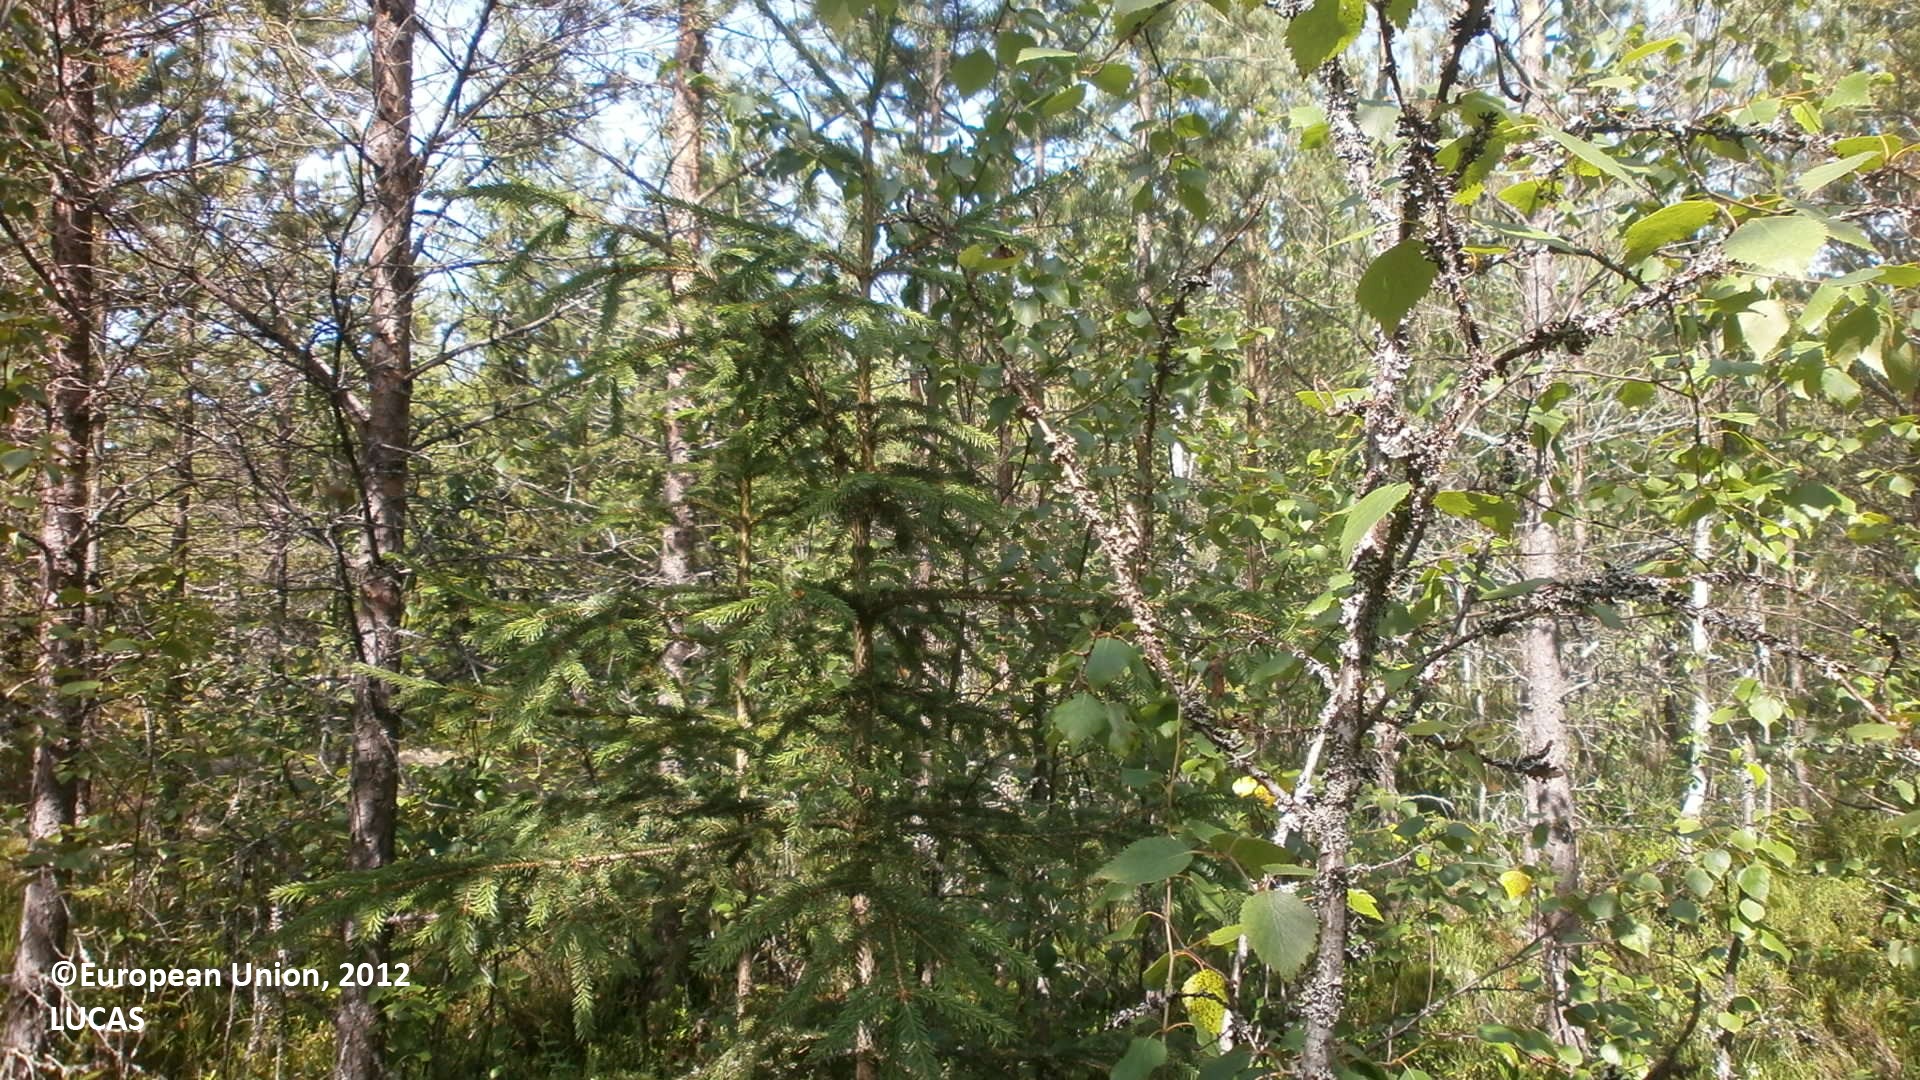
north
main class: Woodland
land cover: Pine dominated mixed woodland
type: boreal forest
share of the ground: 50 - 75 %
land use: Forestry
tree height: > 5 m
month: July
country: FI
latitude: 64.2489
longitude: 24.2395
